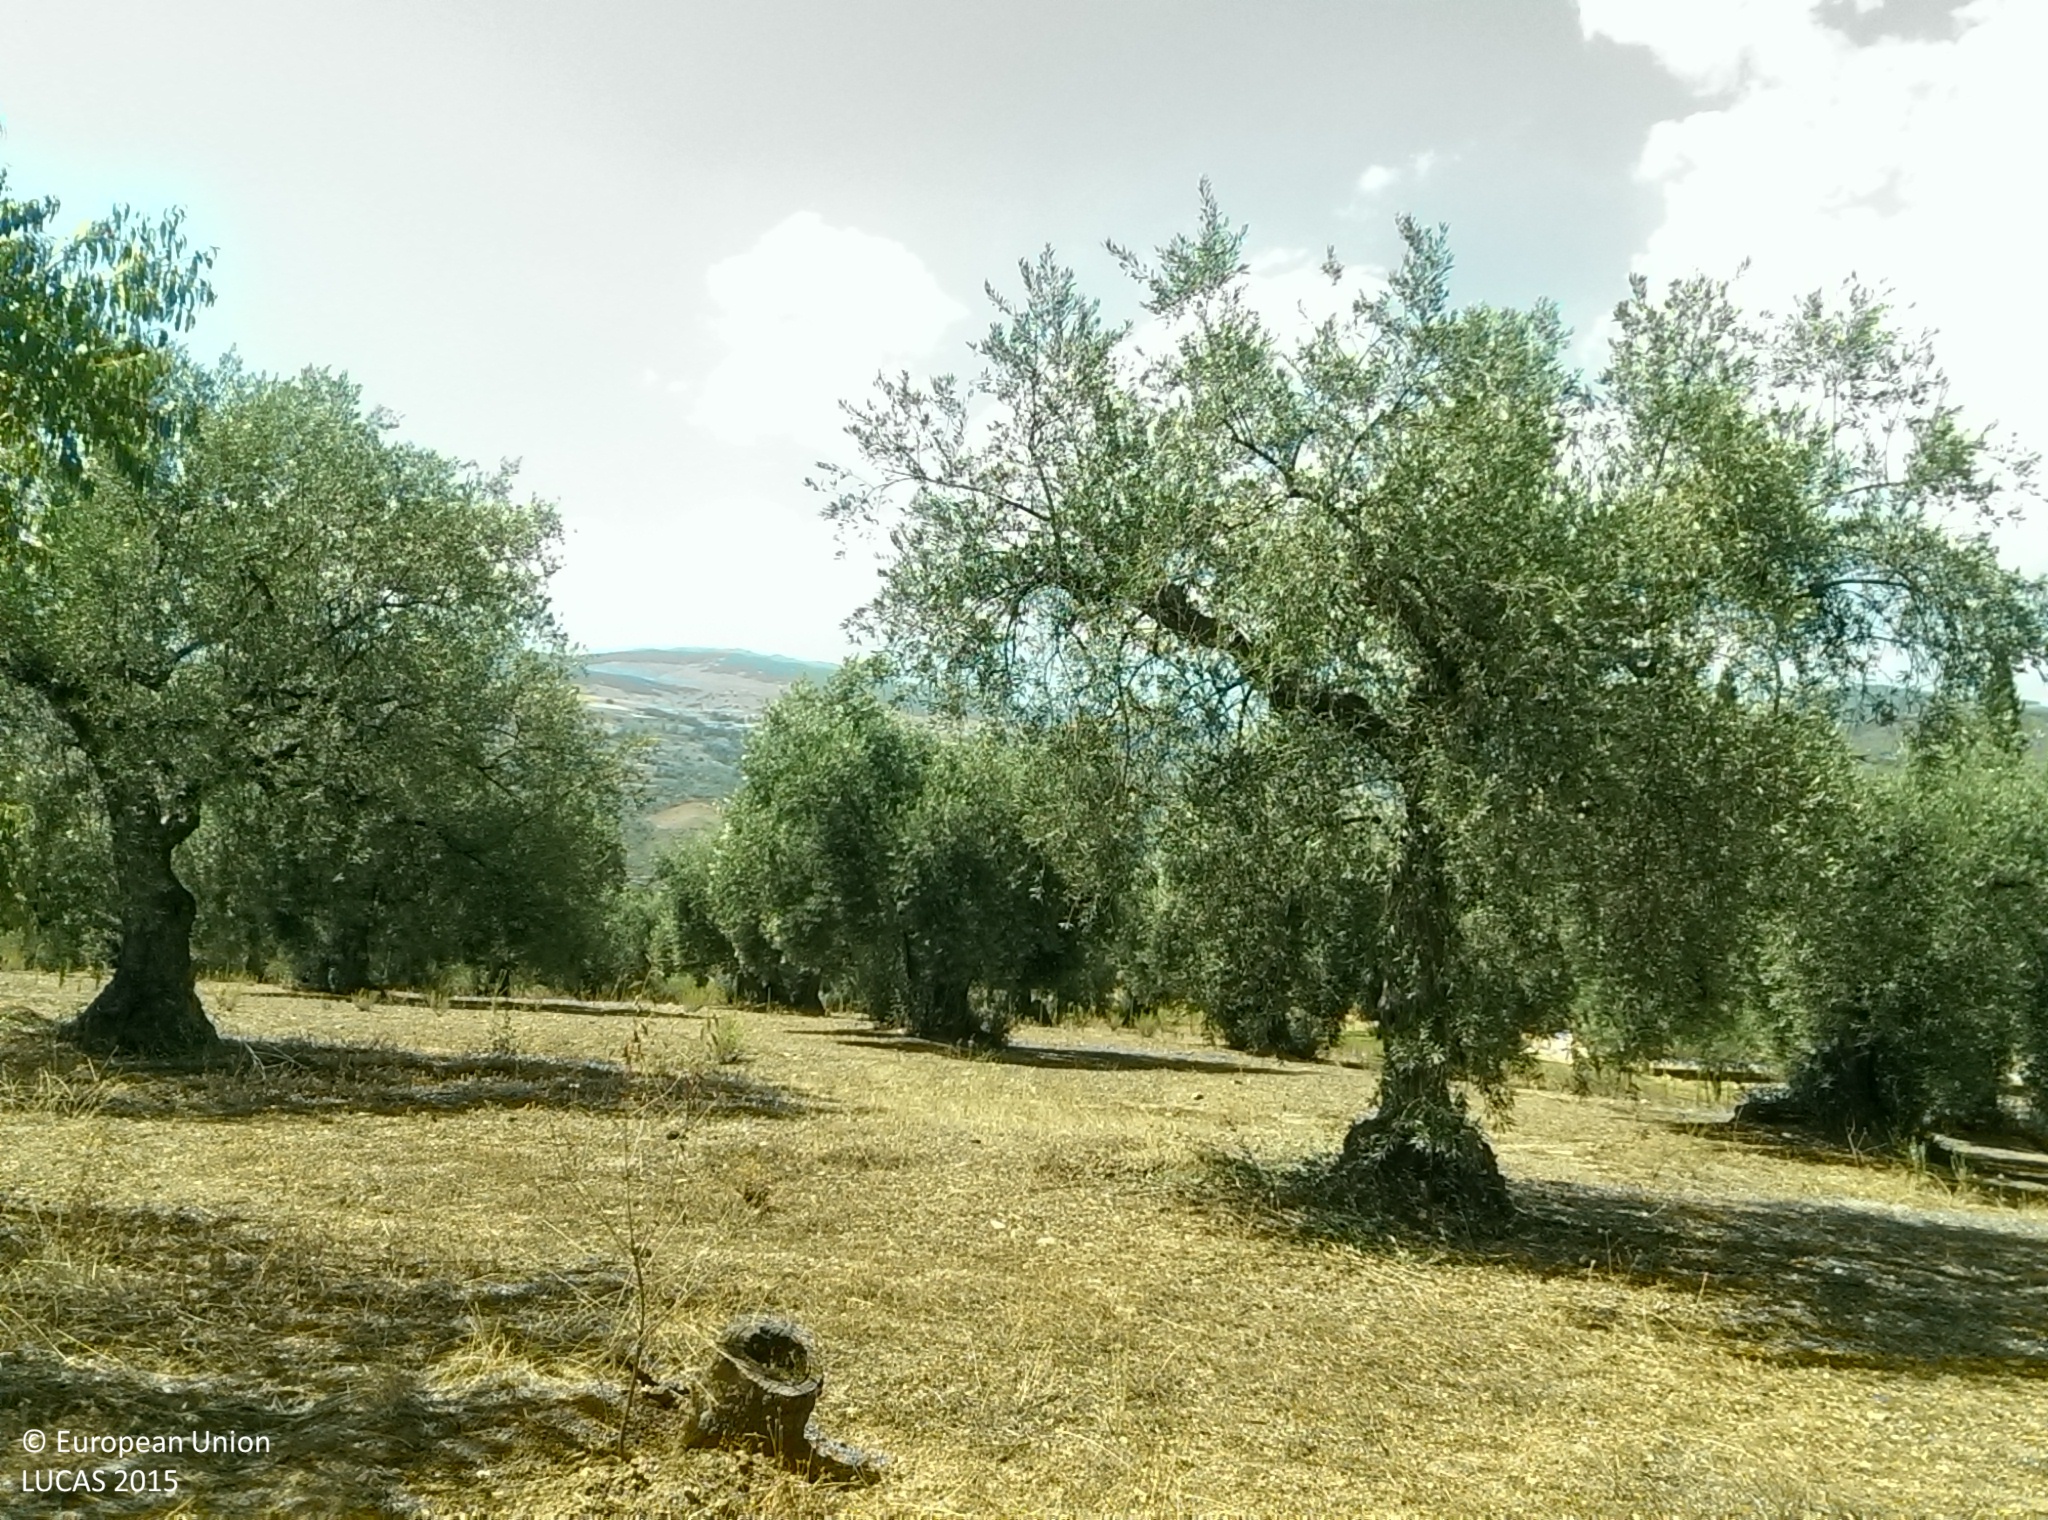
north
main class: Cropland
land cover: Olive groves
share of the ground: 10 - 25 %
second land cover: Nuts trees
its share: 10 - 25 %
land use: Agriculture (excluding fallow land and kitchen gardens)
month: July
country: ES
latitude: 36.9368
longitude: -3.1742
